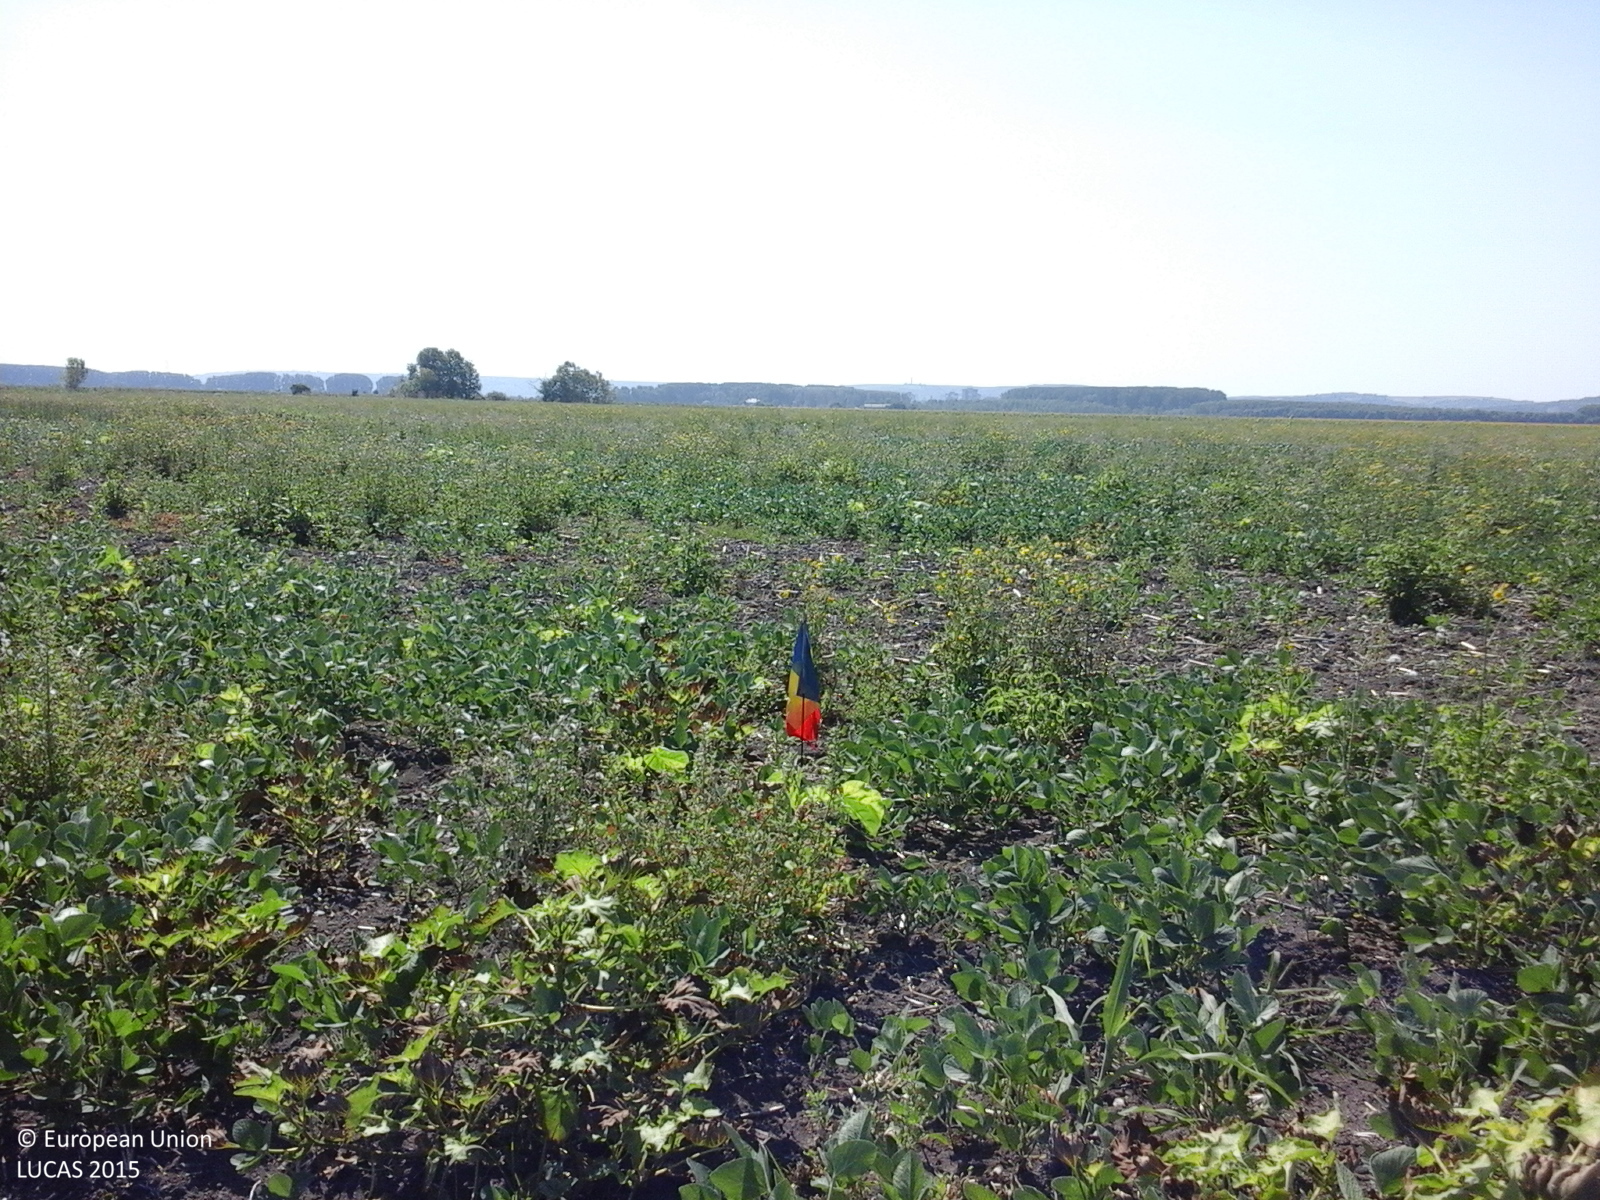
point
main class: Cropland
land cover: Soya
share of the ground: 50 - 75 %
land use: Agriculture (excluding fallow land and kitchen gardens)
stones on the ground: < 10 %
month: July
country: RO
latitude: 44.1452
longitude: 27.2461
